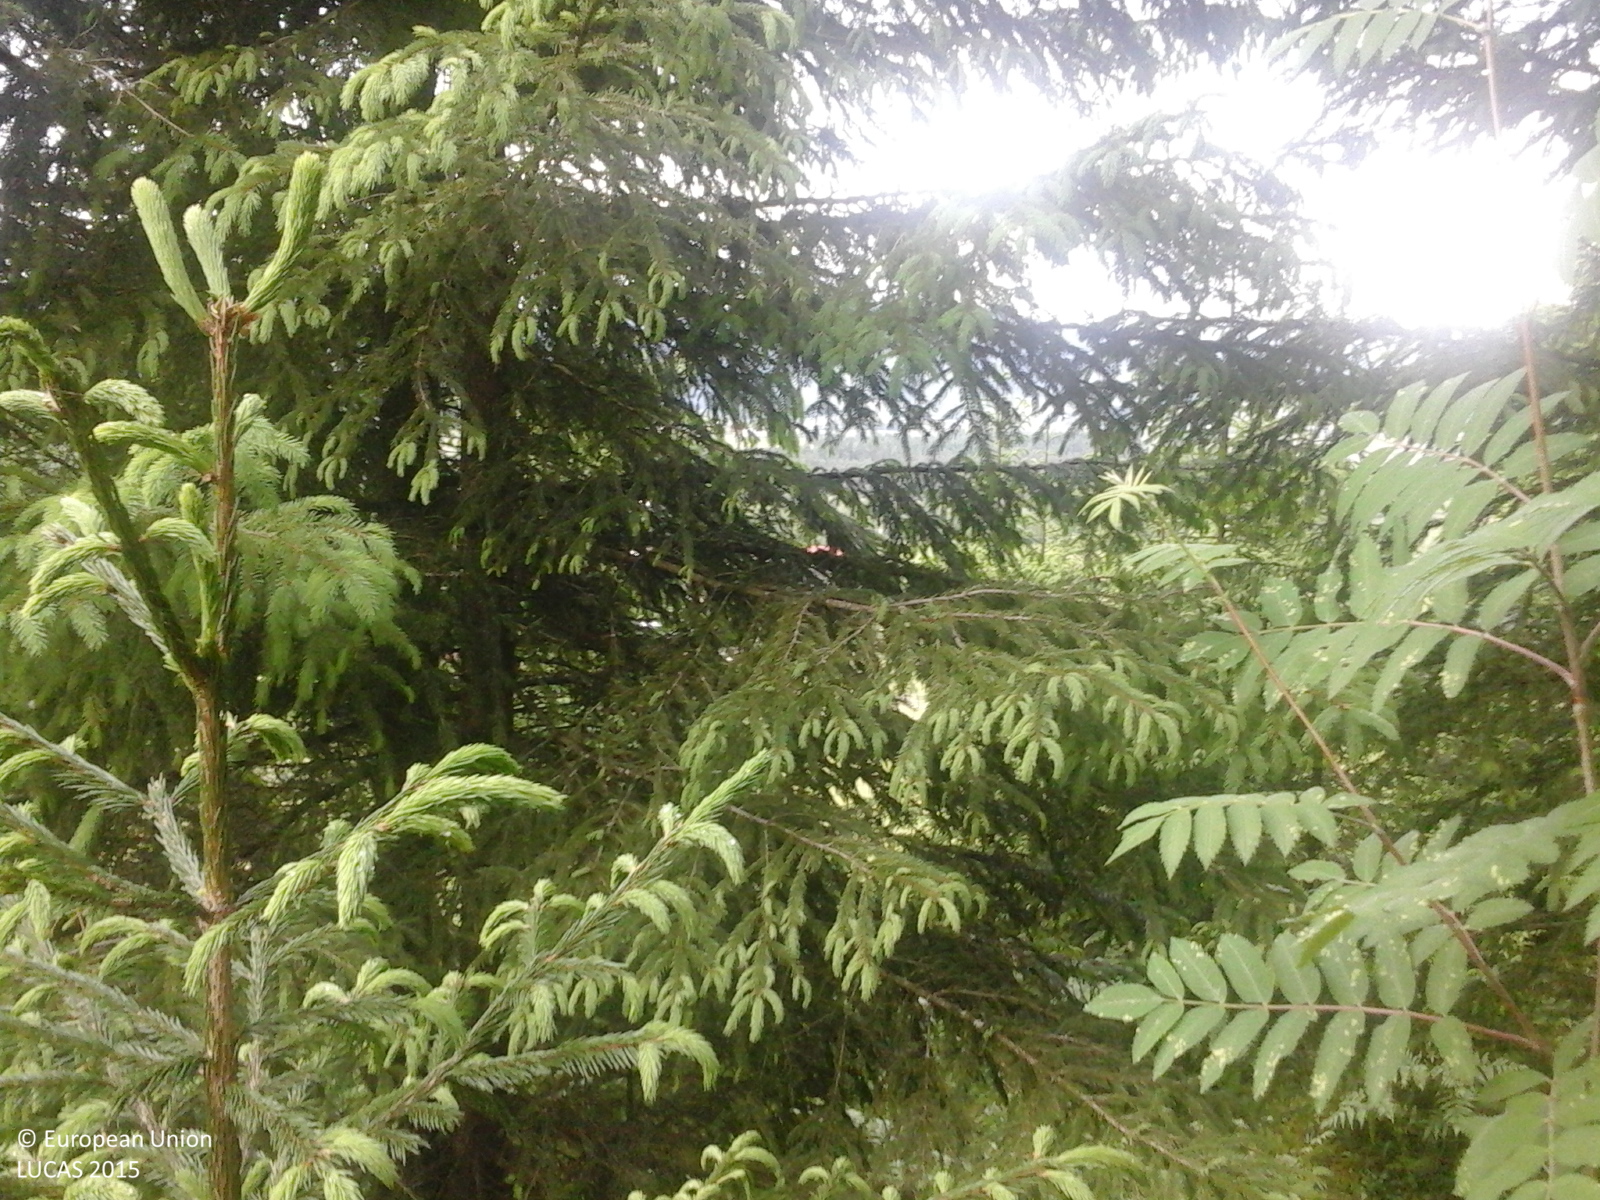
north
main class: Woodland
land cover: Spruce dominated coniferous woodland
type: alpine coniferous forest
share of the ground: > 75 %
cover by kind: coniferous forest trees 85 %, herbaceous plants 10 %, shrubs 5 %
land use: Forestry
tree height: > 5 m
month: June
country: RO
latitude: 47.3680
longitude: 25.1636
